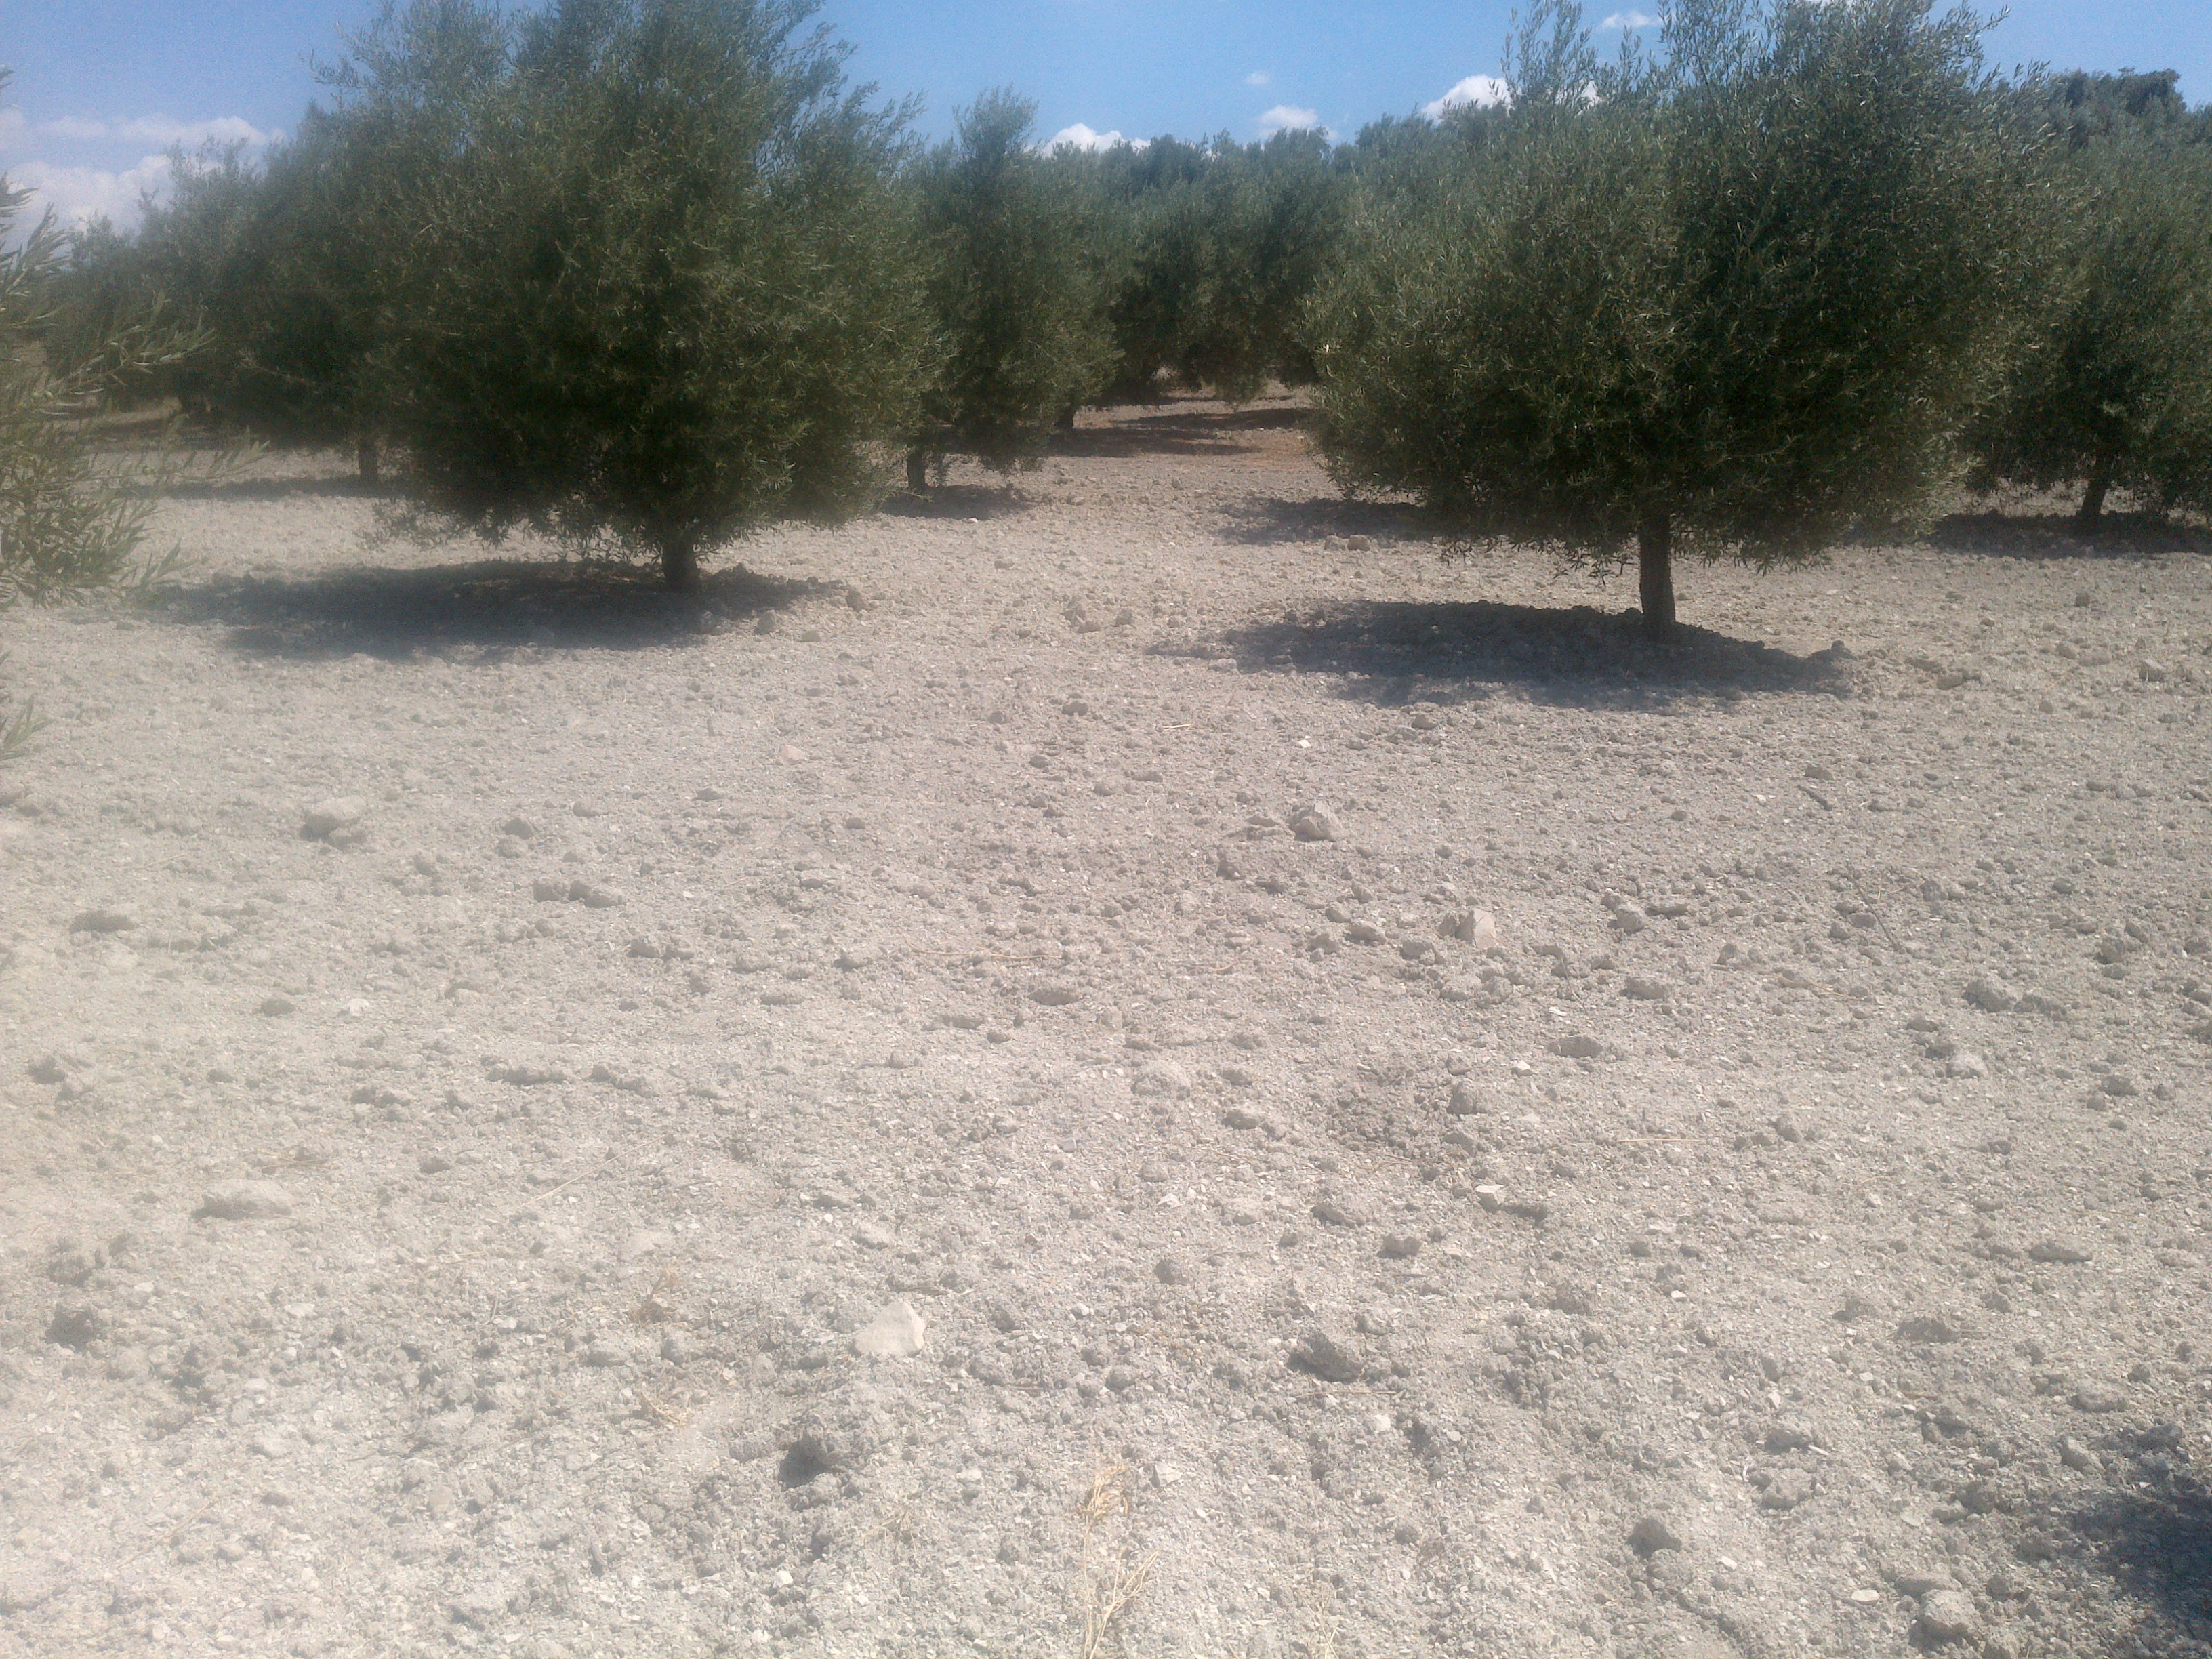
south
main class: Cropland
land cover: Olive groves
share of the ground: 25 - 50 %
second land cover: Other bare soil
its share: > 75 %
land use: Agriculture (excluding fallow land and kitchen gardens)
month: June
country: ES
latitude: 37.7638
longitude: -4.2979
